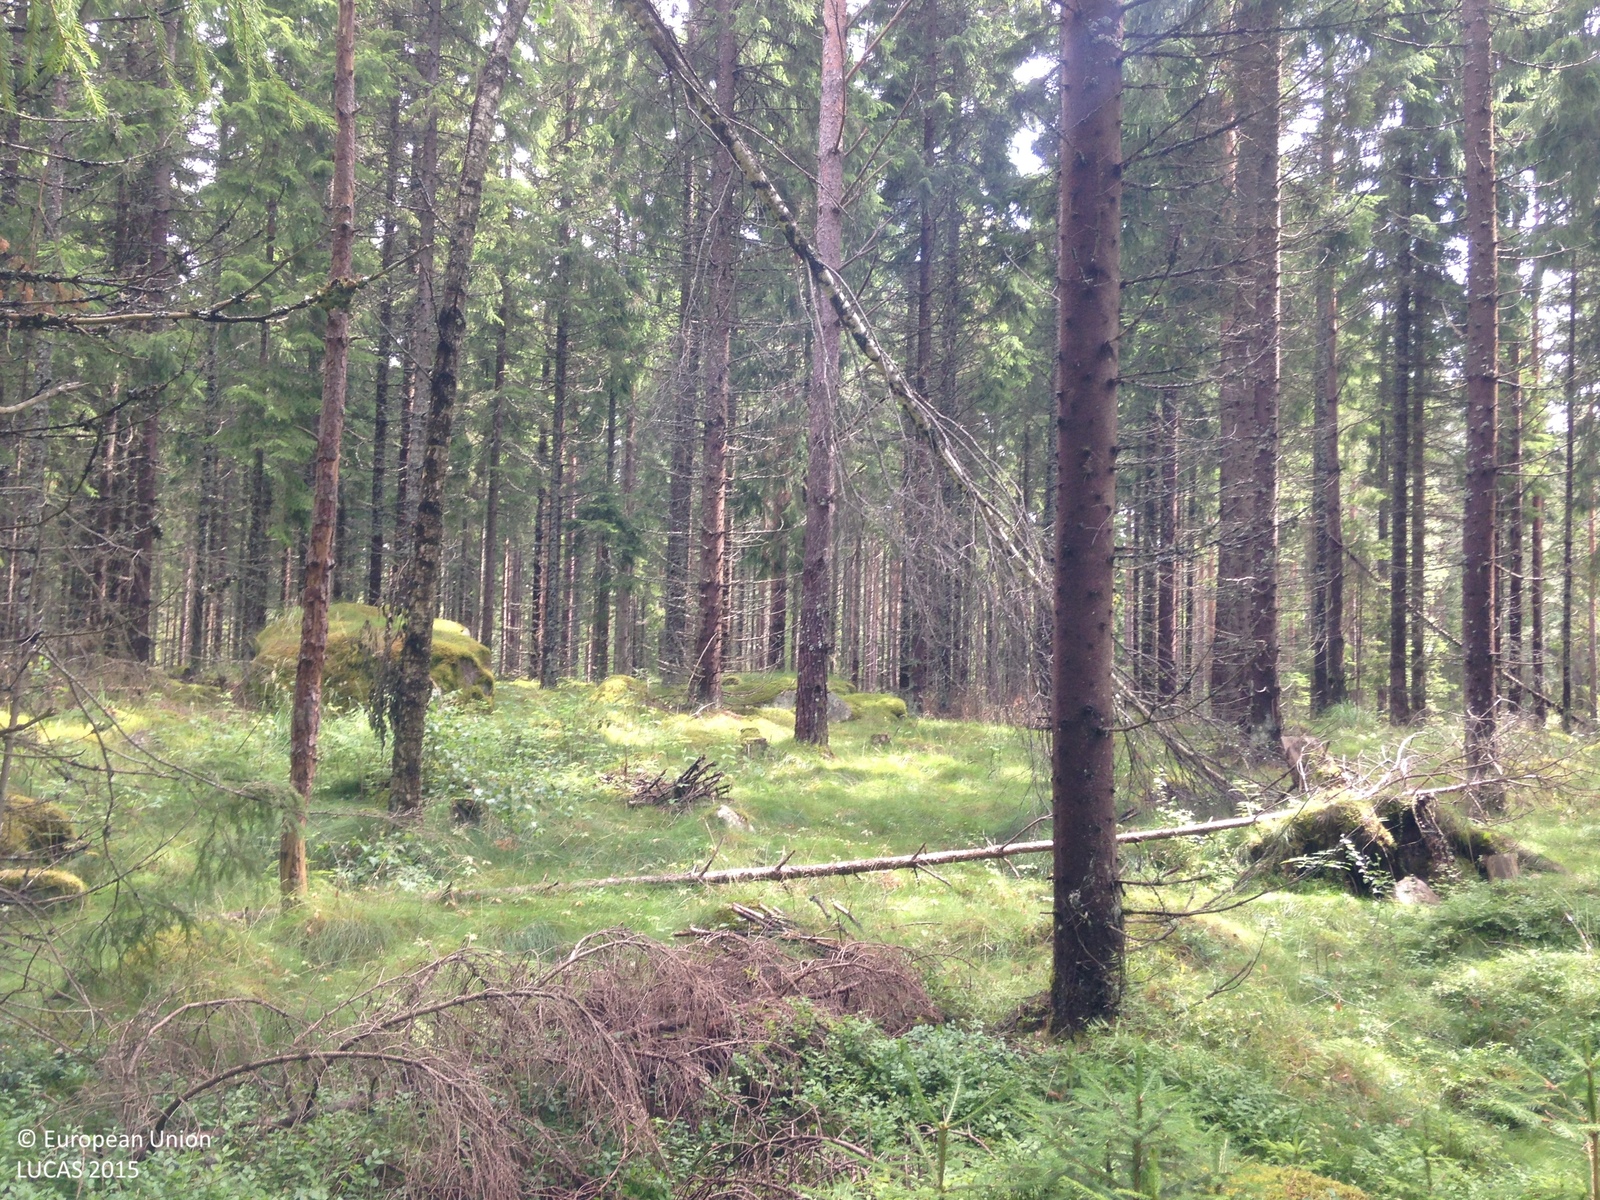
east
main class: Woodland
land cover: Other coniferous woodland
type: boreal forest
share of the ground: 25 - 50 %
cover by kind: coniferous forest trees 40 %, herbaceous plants 35 %, lichens and mosses 20 %, broadleaved forest trees 5 %
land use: Forestry
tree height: > 5 m
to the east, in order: Other coniferous woodland; Spruce dominated coniferous woodland; Tracks; Other coniferous woodland; Pine dominated mixed woodland; Other mixed woodland; Spruce dominated coniferous woodland; Tracks; Spruce dominated coniferous woodland; Tracks; Other coniferous woodland
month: July
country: SE
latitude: 58.9946
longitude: 14.3957
